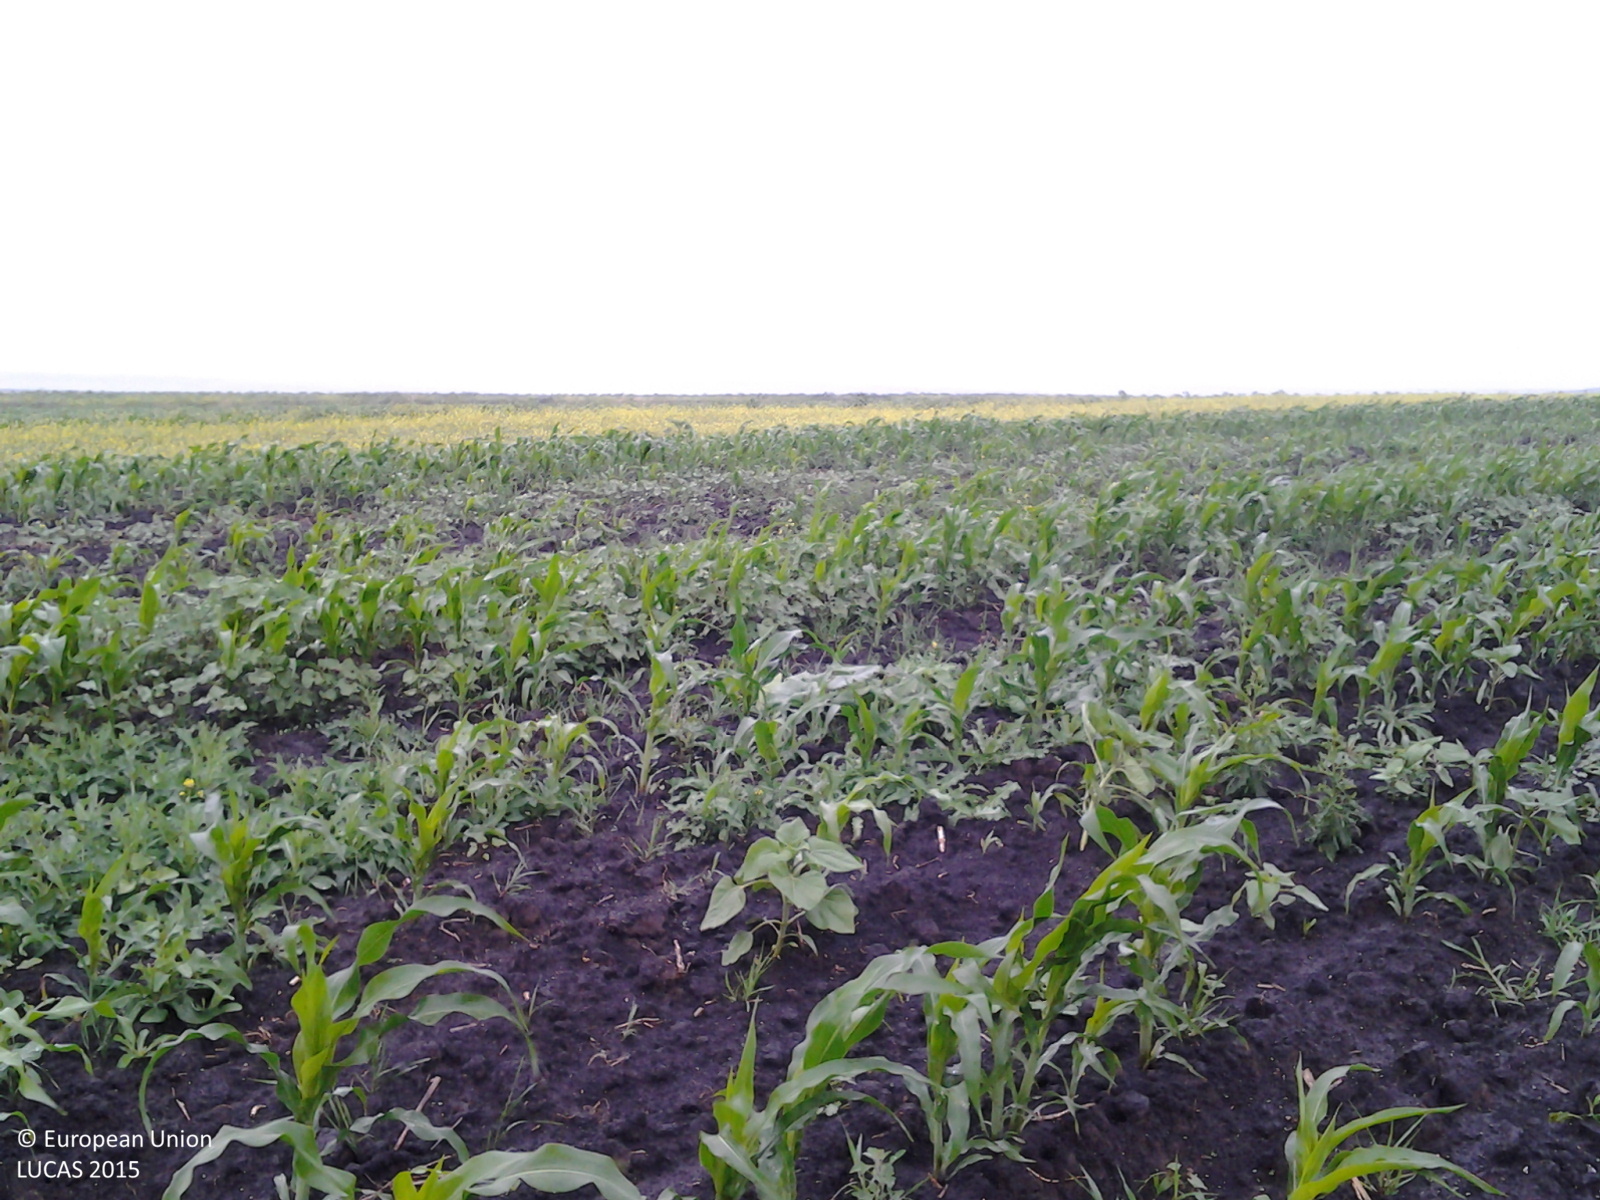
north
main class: Cropland
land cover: Maize
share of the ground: 10 - 25 %
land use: Agriculture (excluding fallow land and kitchen gardens)
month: June
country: RO
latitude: 47.9004
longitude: 26.5326
